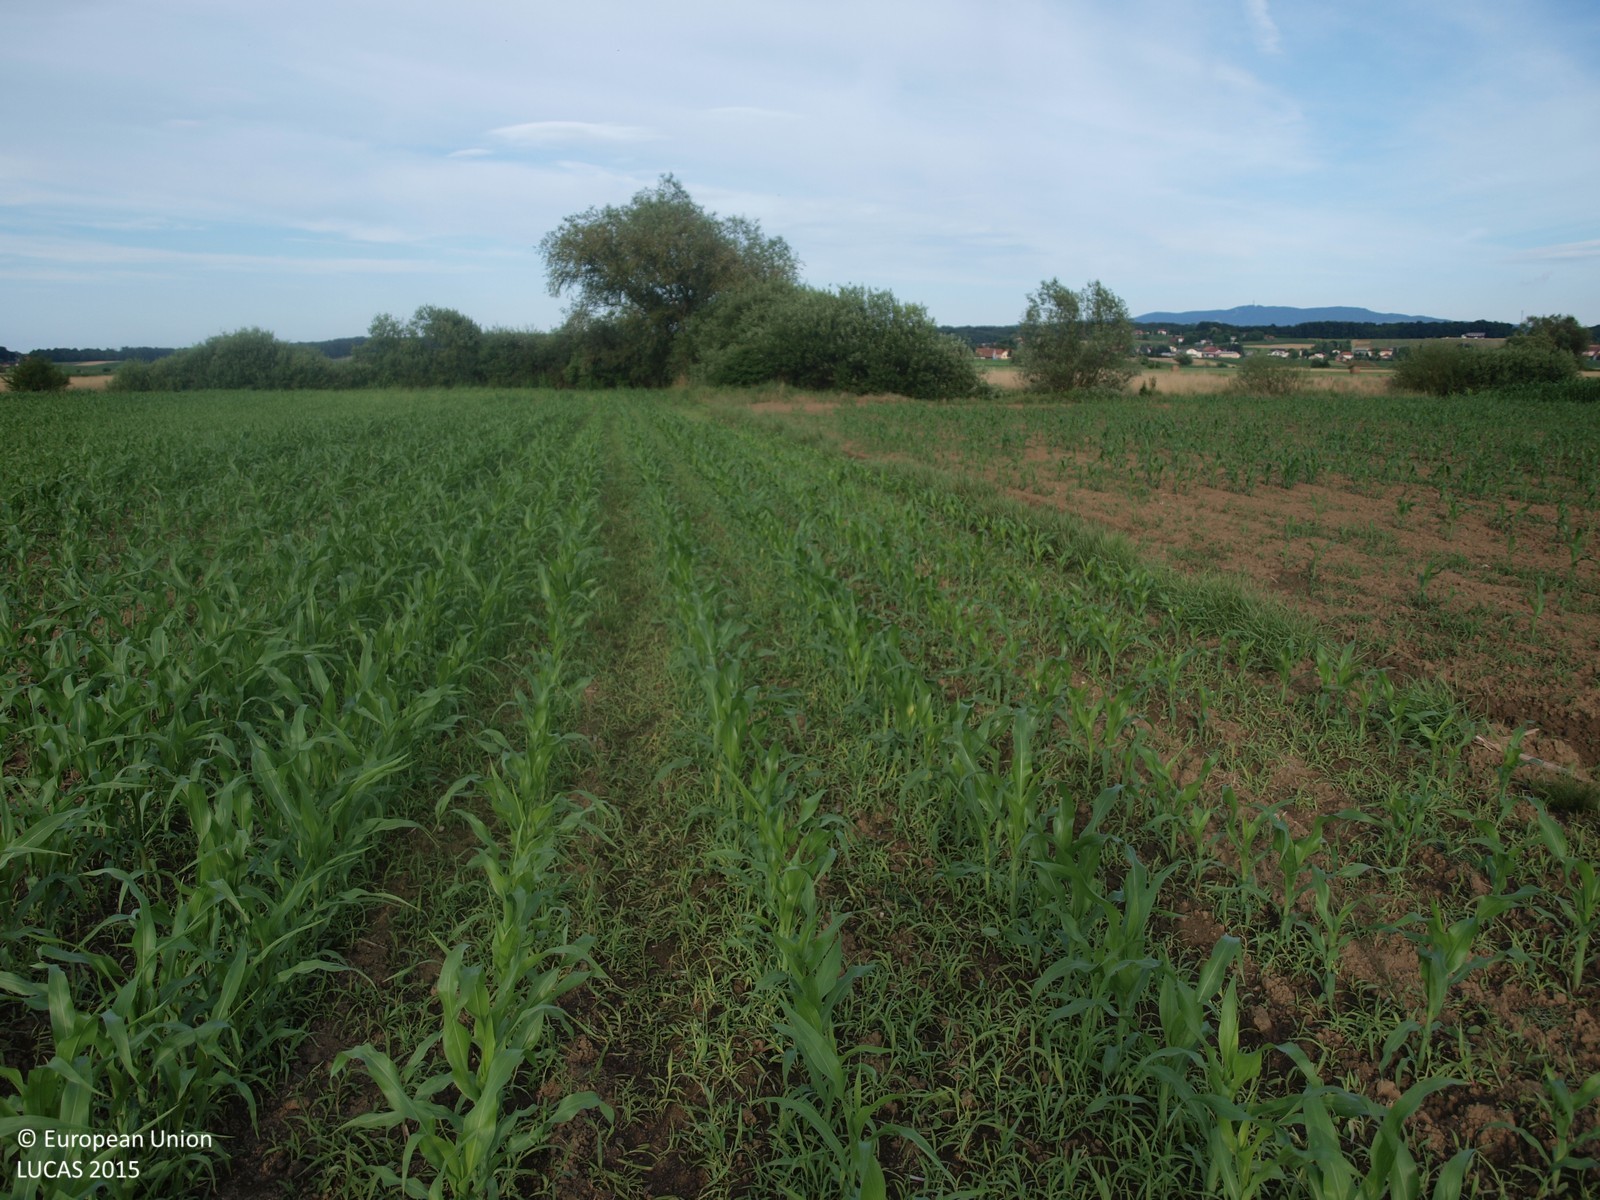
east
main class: Cropland
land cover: Maize
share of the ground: > 75 %
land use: Agriculture (excluding fallow land and kitchen gardens)
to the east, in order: Maize; Shrubland with sparse tree cover; Ditches and canals; Shrubland with sparse tree cover; Grassland without tree/shrub cover
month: June
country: HR
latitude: 45.9637
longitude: 15.7142
